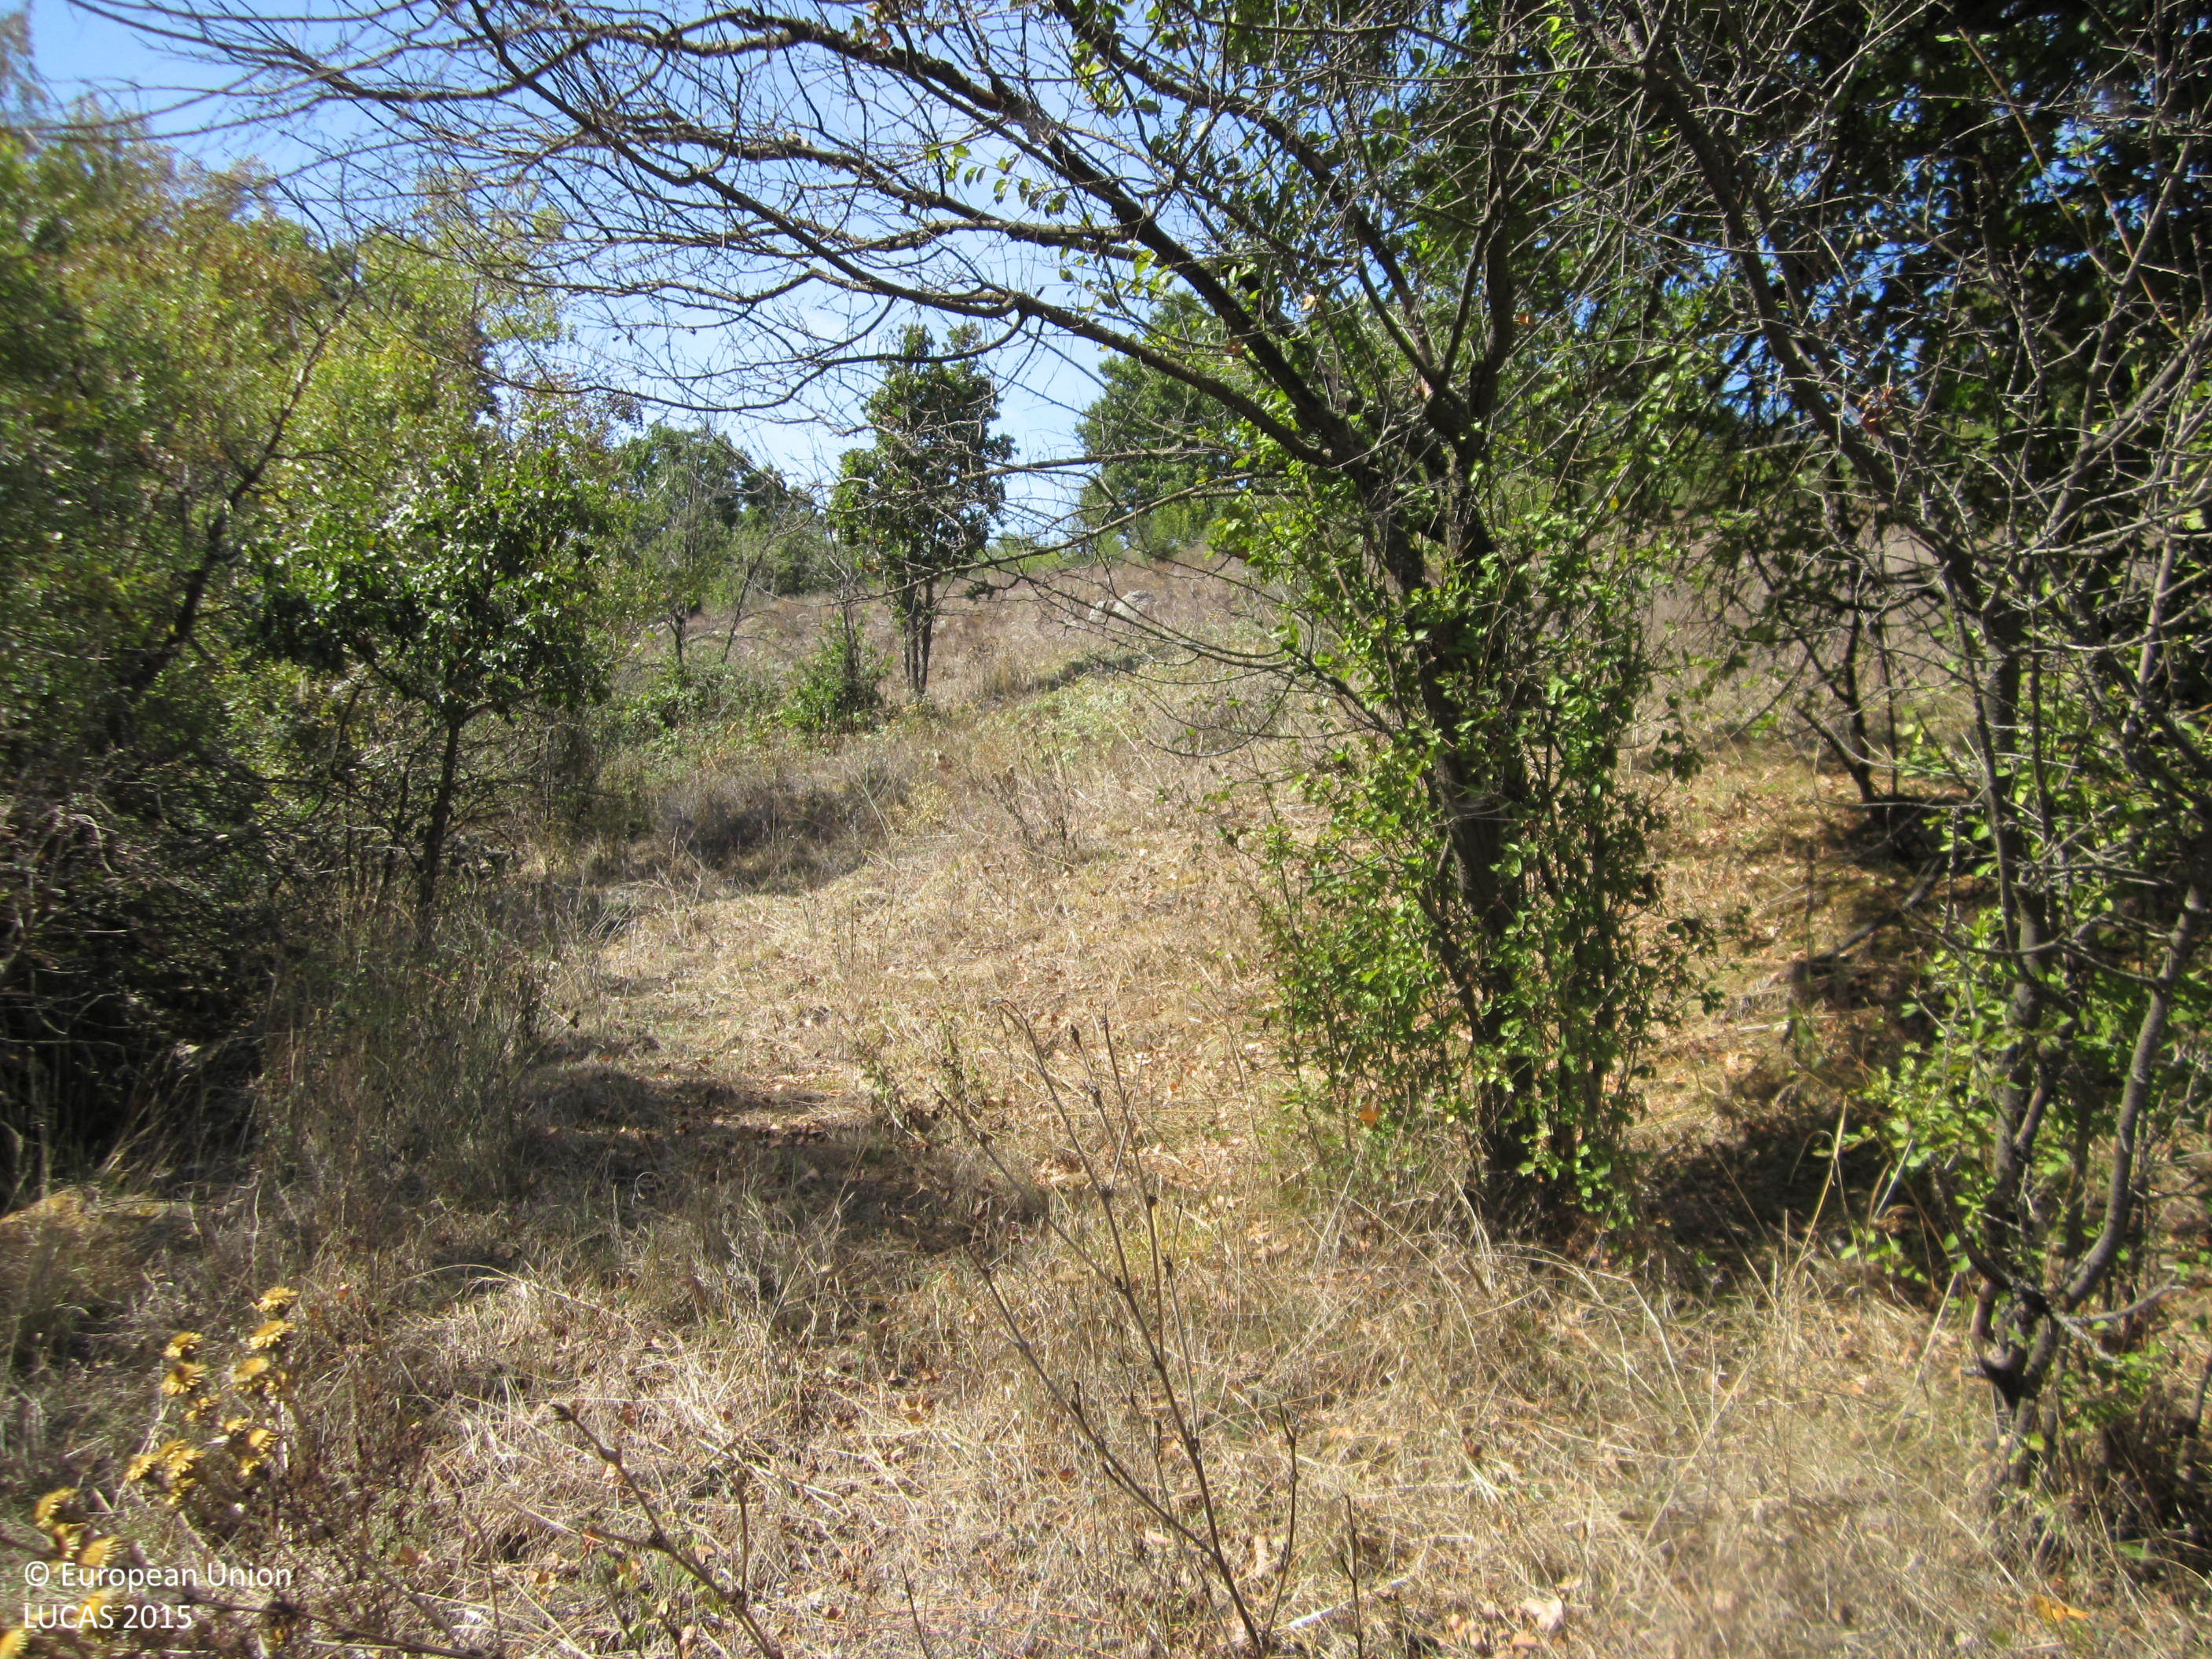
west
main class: Shrubland
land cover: Shrubland with sparse tree cover
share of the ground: 50 - 75 %
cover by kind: shrubs 65 %, herbaceous plants 30 %, broadleaved forest trees 5 %
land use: Semi-natural and natural areas not in use
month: September
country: BG
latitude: 42.2173
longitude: 27.0000
